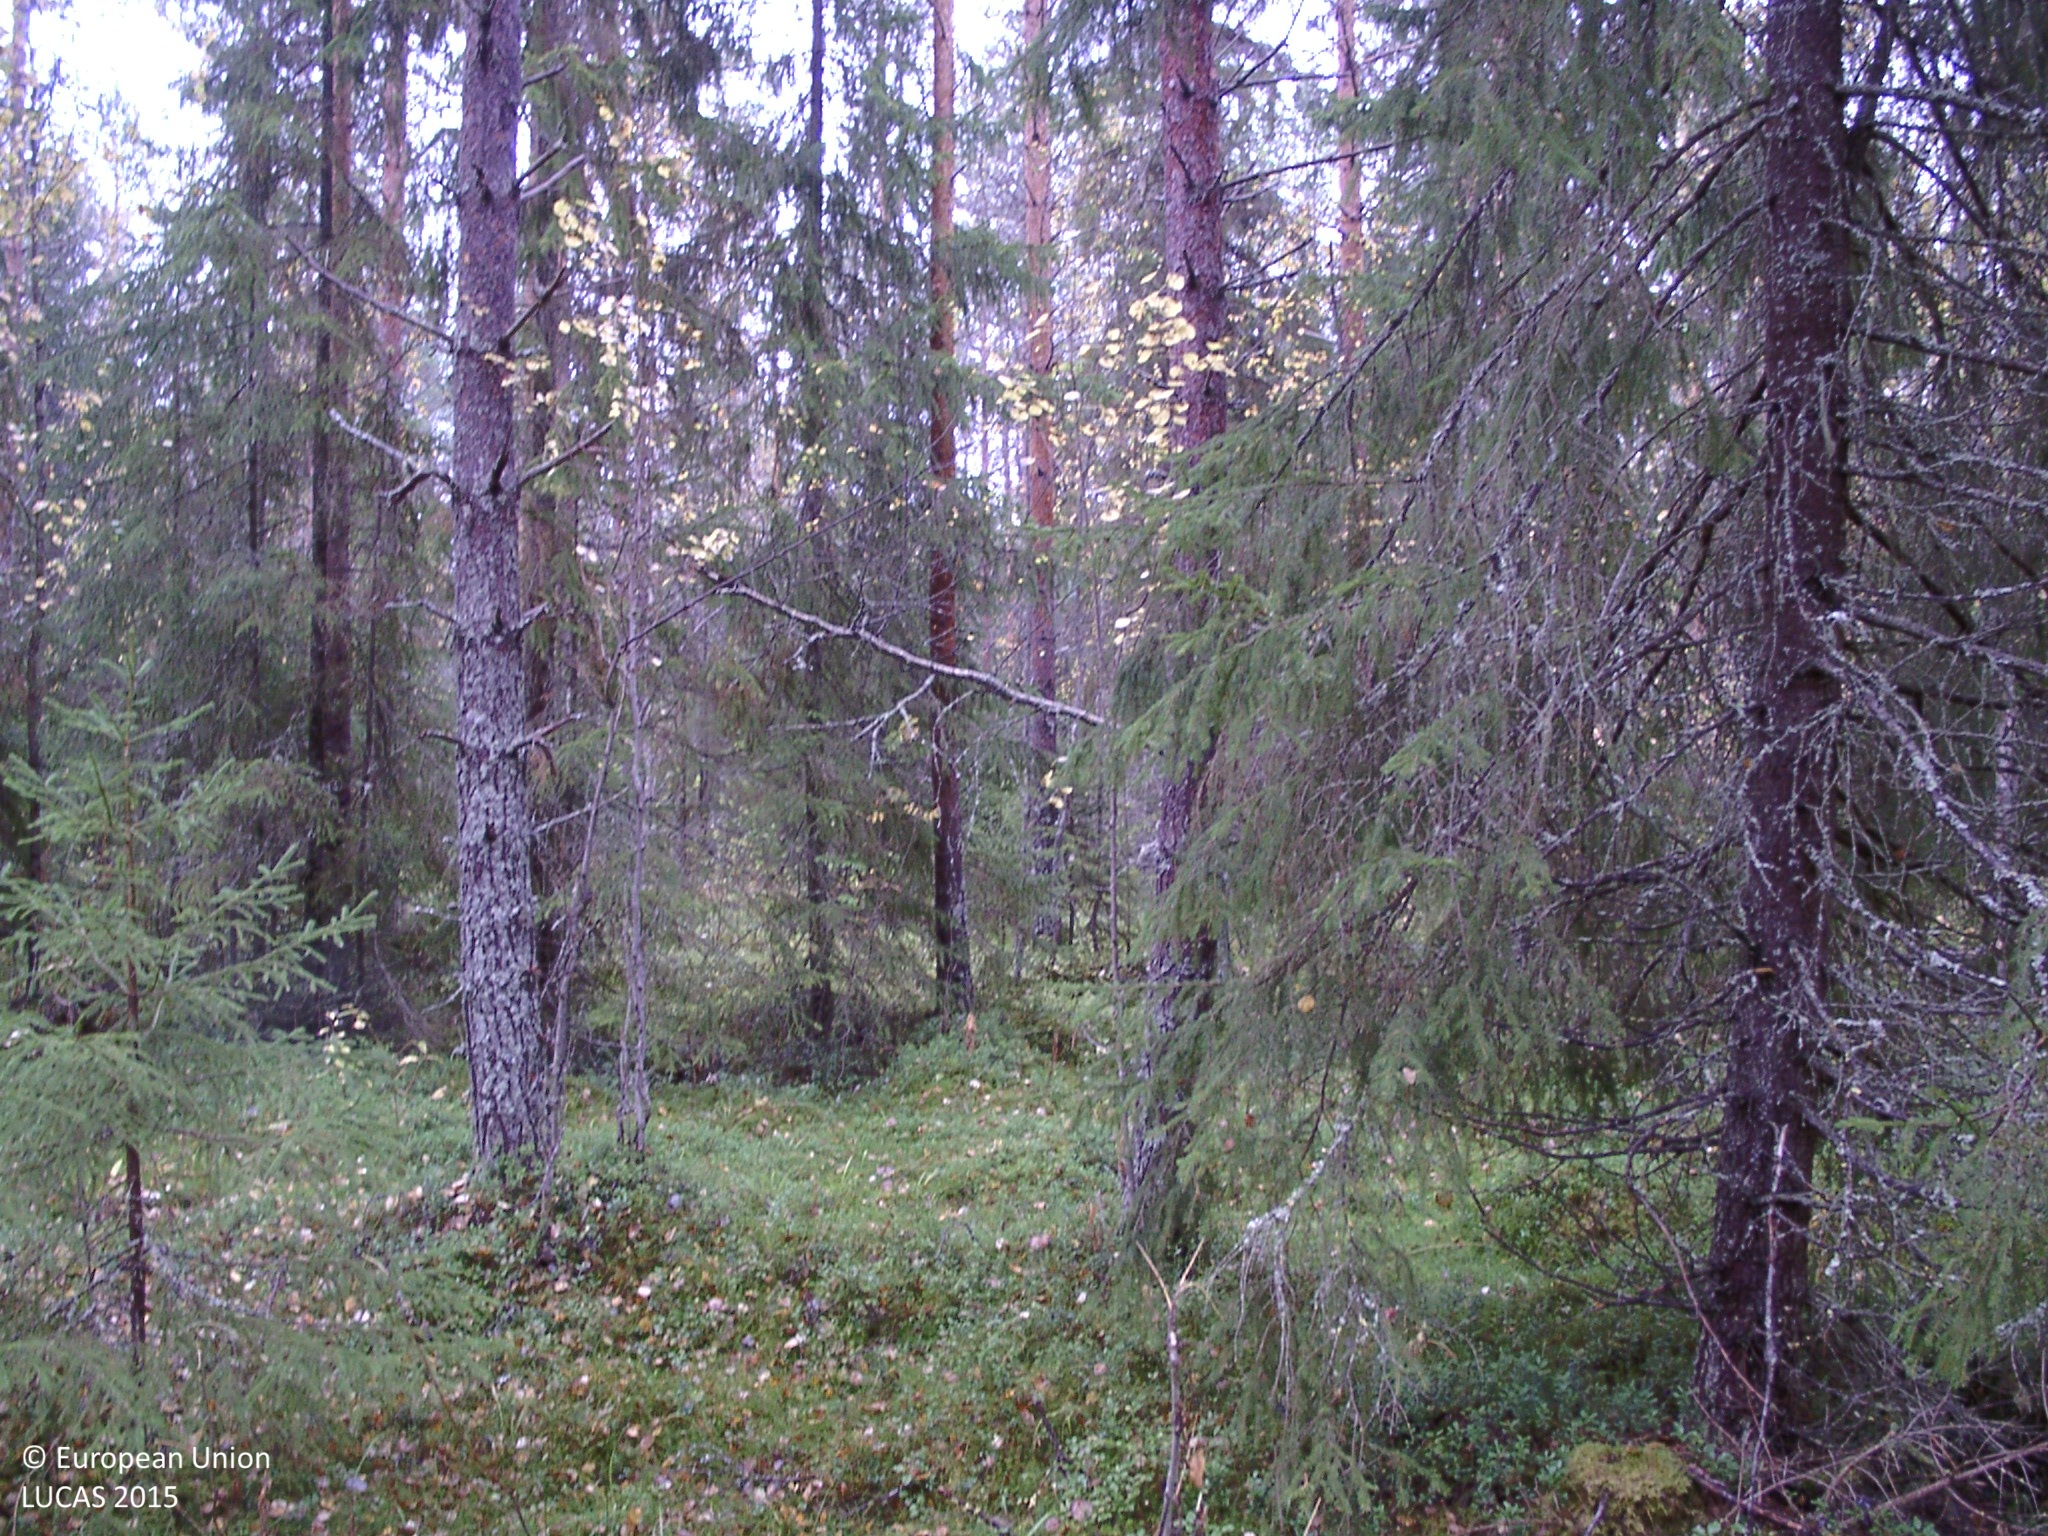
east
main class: Woodland
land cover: Other mixed woodland
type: boreal forest
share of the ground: 50 - 75 %
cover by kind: coniferous forest trees 40 %, shrubs 20 %, broadleaved forest trees 15 %, lichens and mosses 15 %, herbaceous plants 10 %
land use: Forestry
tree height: > 5 m
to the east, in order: Other mixed woodland; Ditches and canals; Other mixed woodland; Ditches and canals; Managed hedges; Tracks; Grass margins; Shruby margins; Ditches and canals; Pine dominated mixed woodland; Pine dominated coniferous woodland; Other mixed woodland
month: September
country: FI
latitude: 62.8335
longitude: 25.5200
